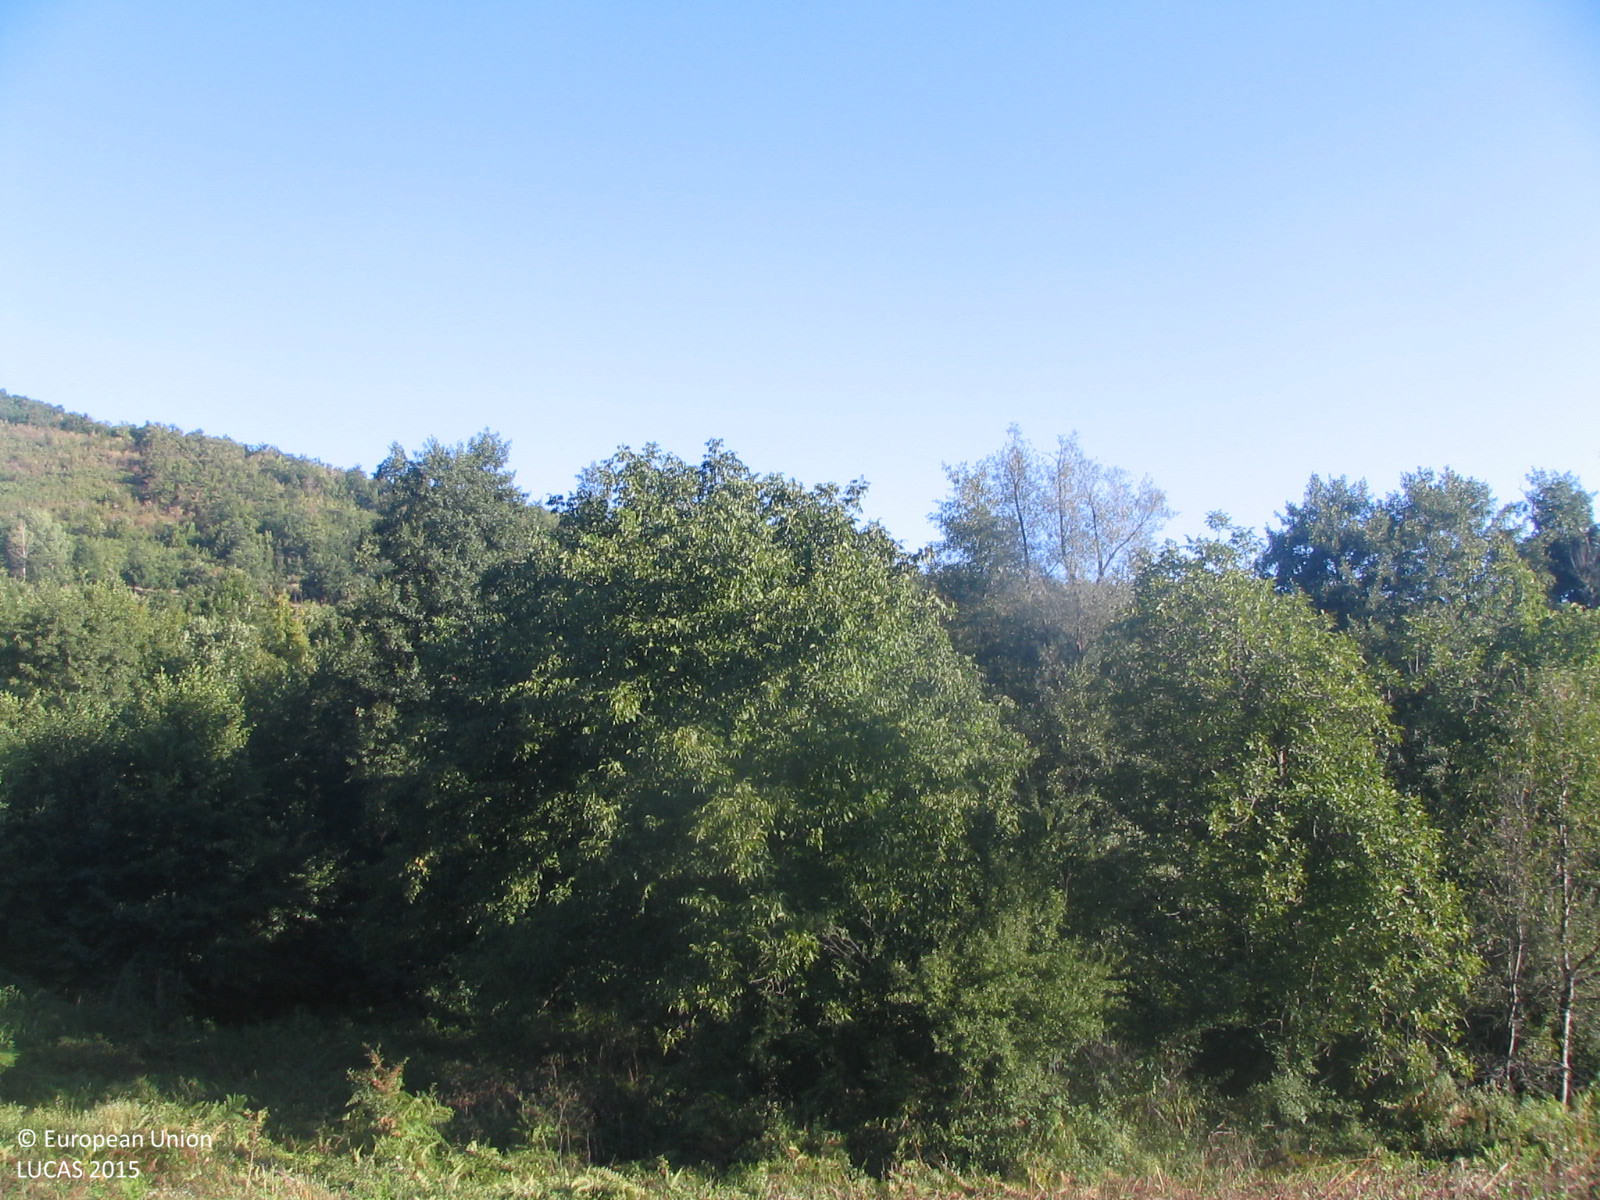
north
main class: Woodland
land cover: Broadleaved woodland
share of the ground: 50 - 75 %
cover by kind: broadleaved forest trees 60 %, shrubs 25 %, herbaceous plants 15 %
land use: Abandoned areas
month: September
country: BG
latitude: 42.9579
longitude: 24.3840
